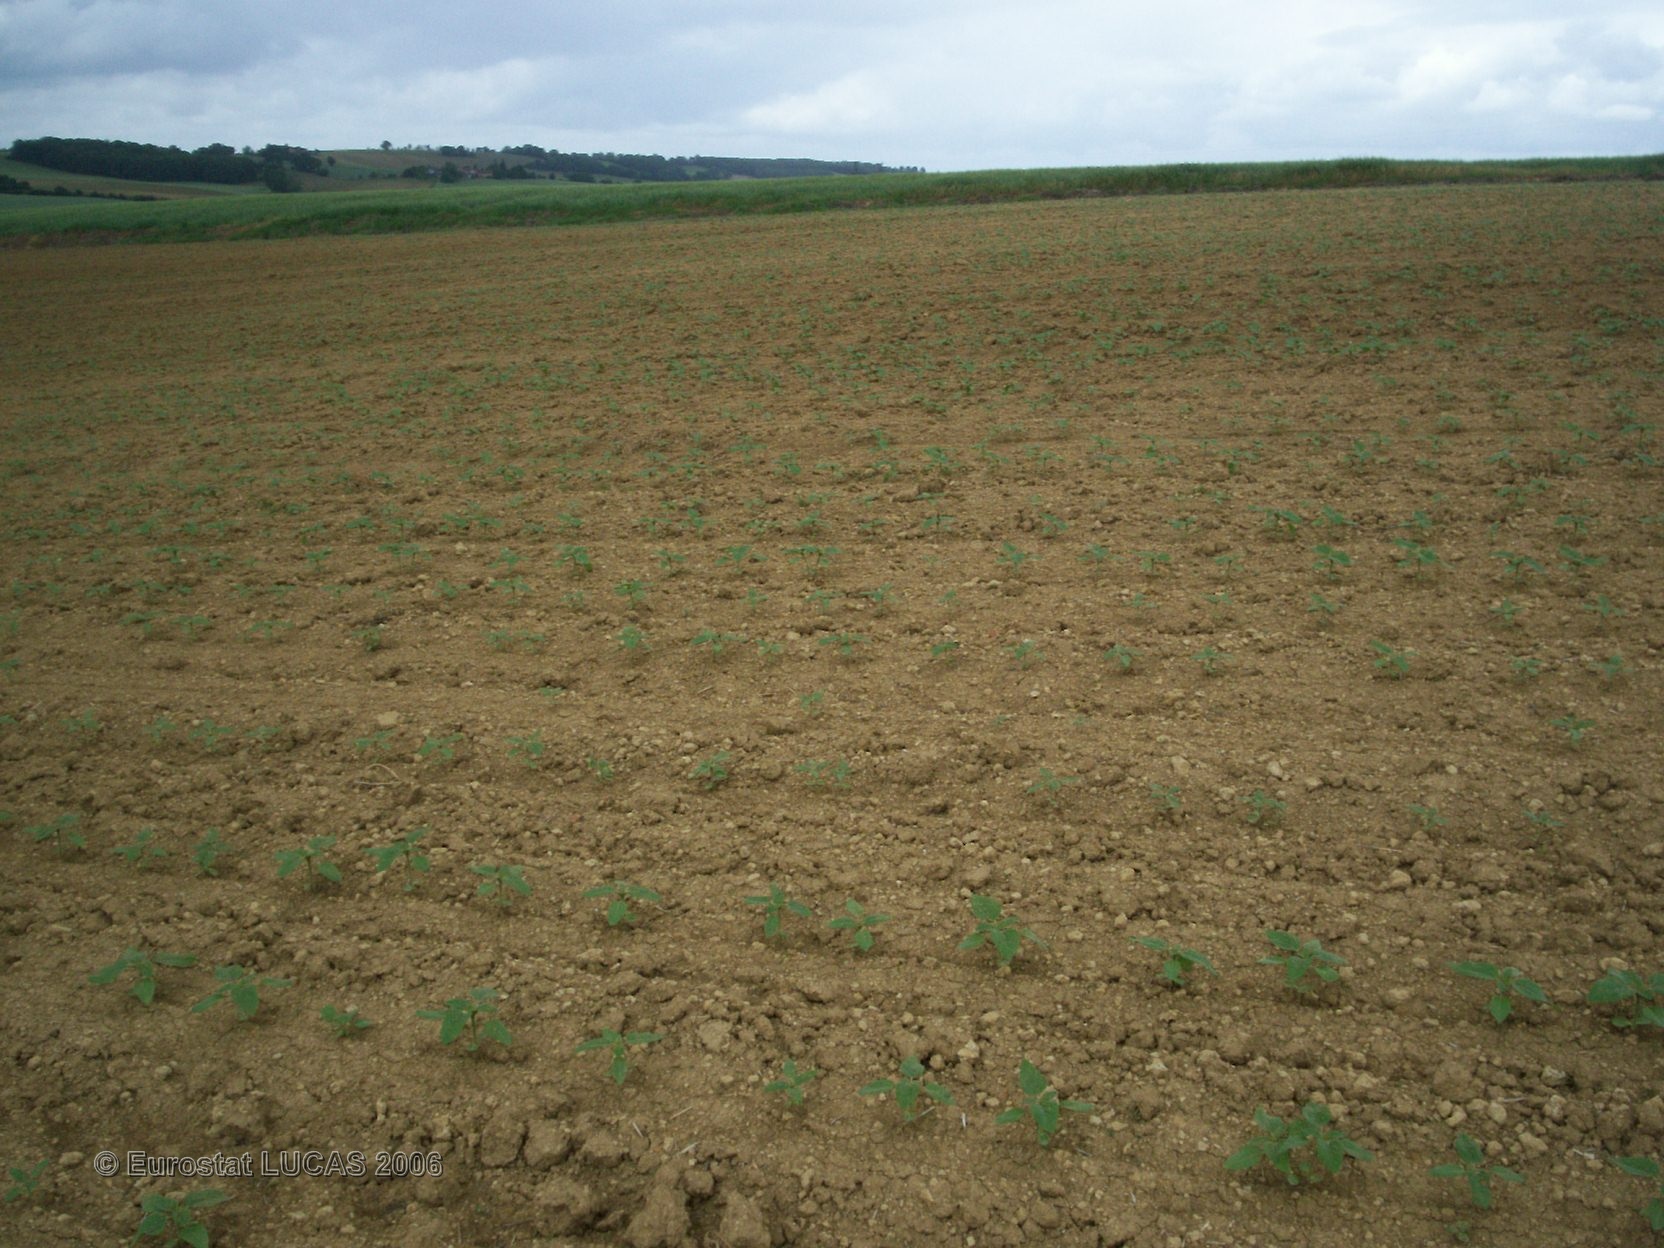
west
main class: Cropland
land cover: Soya
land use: Agriculture (excluding fallow land and kitchen gardens)
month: May
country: FR
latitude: 43.5755
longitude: 0.9732
